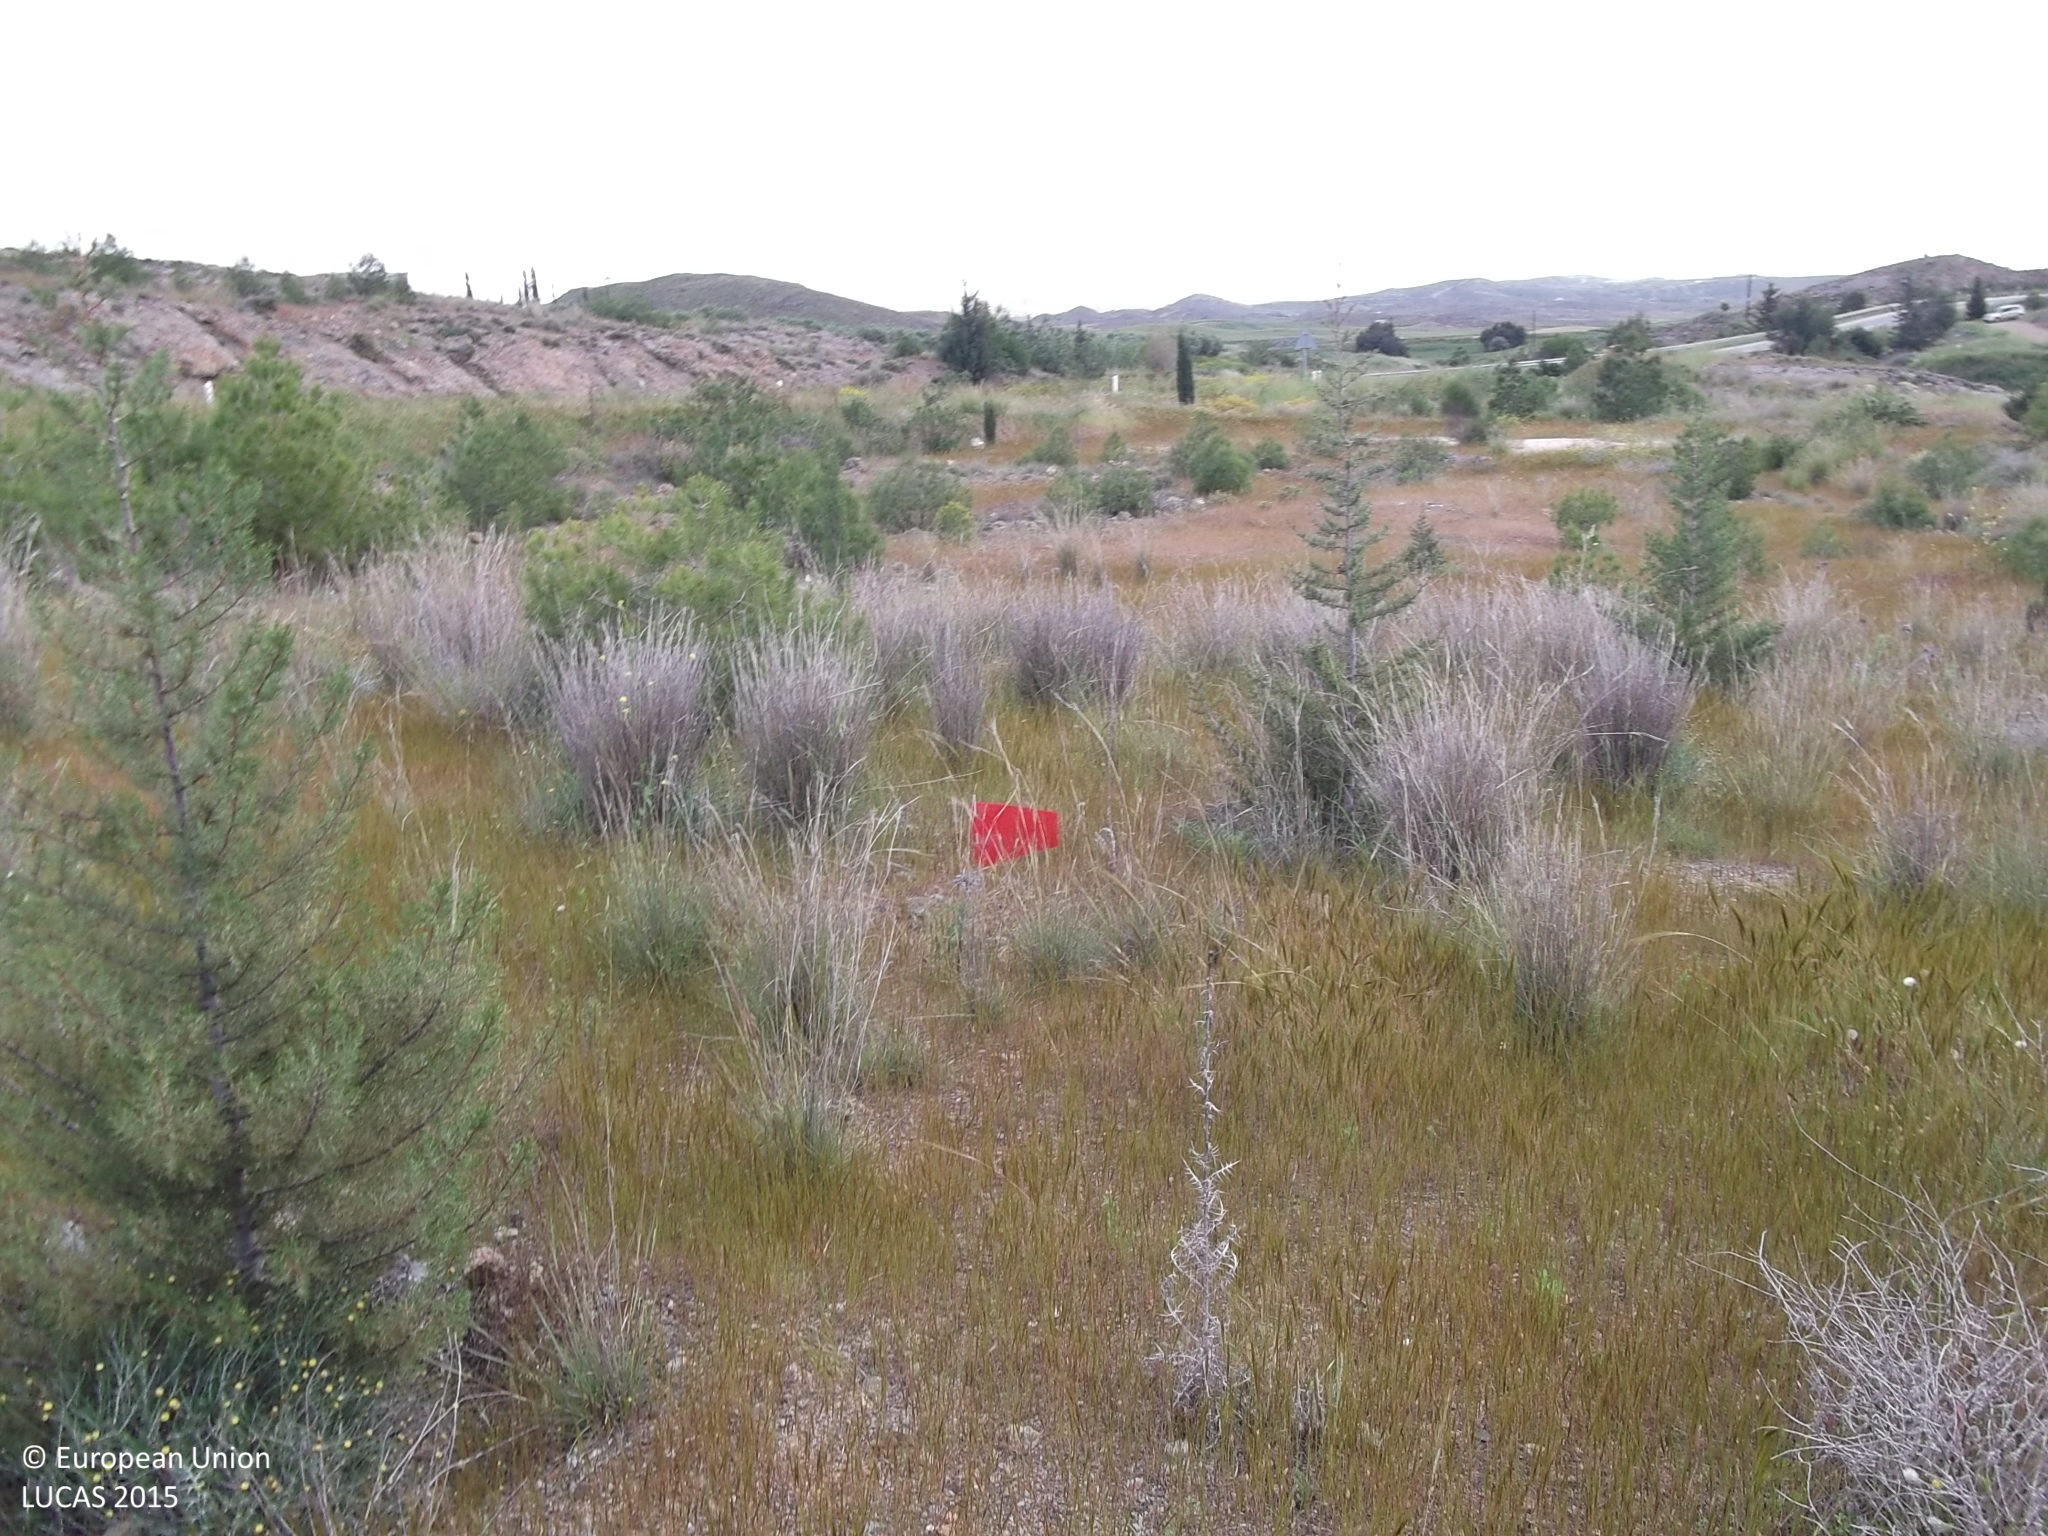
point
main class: Shrubland
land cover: Shrubland with sparse tree cover
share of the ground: 50 - 75 %
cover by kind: shrubs 55 %, herbaceous plants 30 %, consolidated bare surface 10 %, coniferous forest trees 5 %
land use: Semi-natural and natural areas not in use
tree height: < 5 m
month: April
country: CY
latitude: 35.0034
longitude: 33.5686
